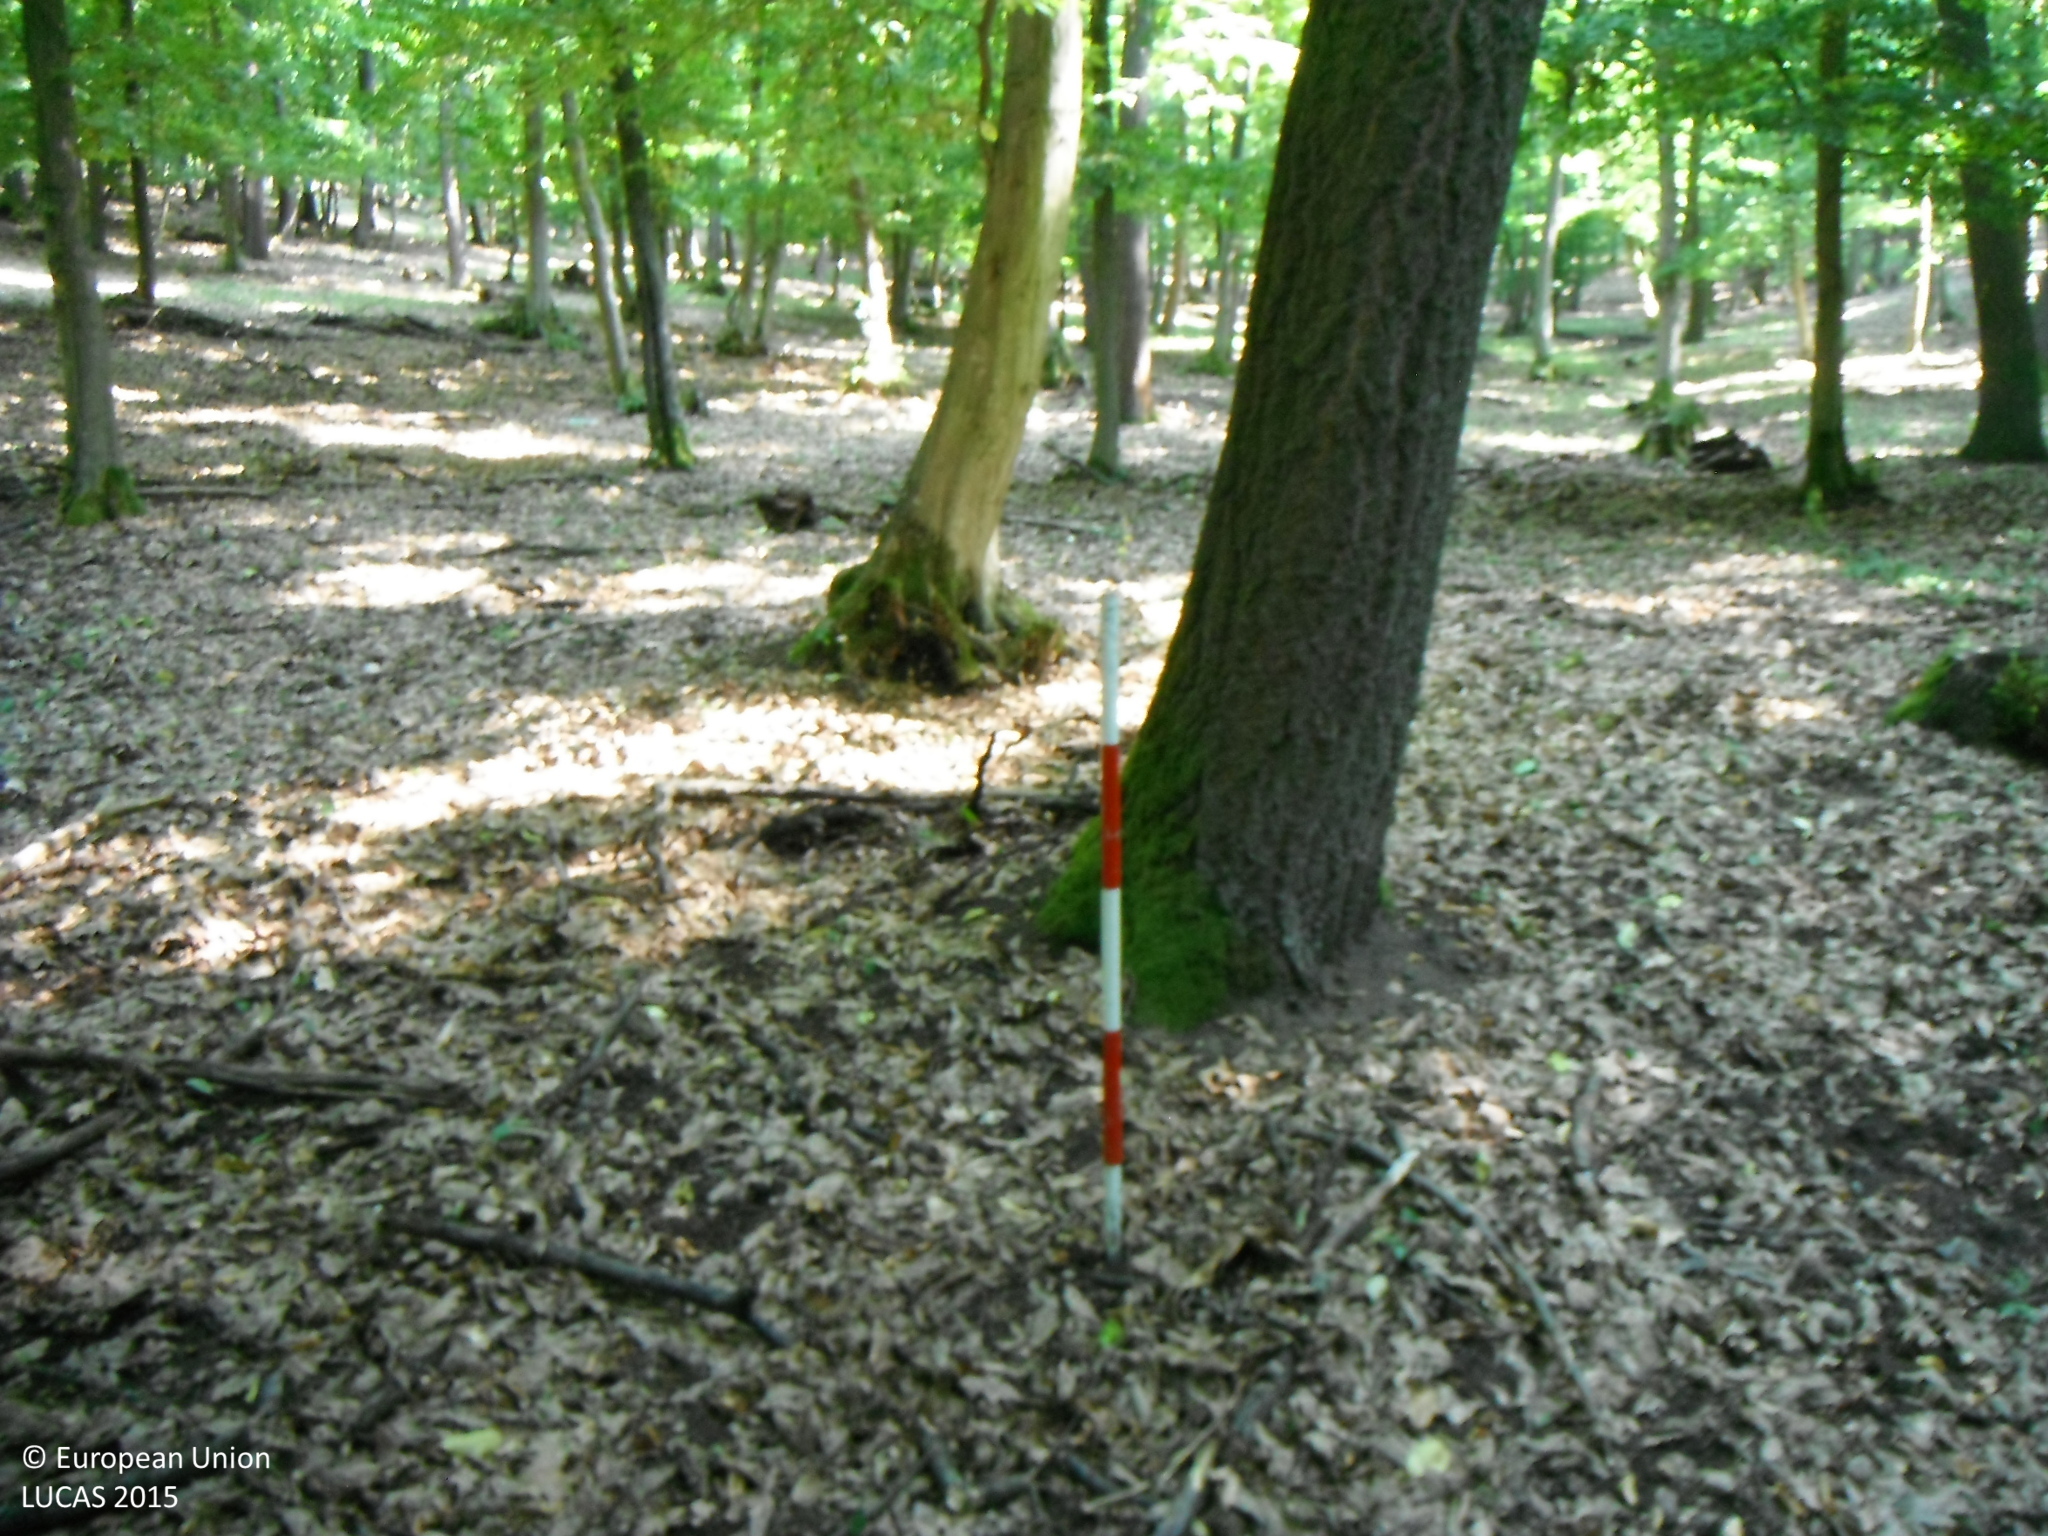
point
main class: Woodland
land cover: Broadleaved woodland
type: acidophilous oak and oak-birch forest
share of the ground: > 75 %
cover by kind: broadleaved forest trees 90 %, unconsolidated bare surface 10 %
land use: Forestry
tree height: > 5 m
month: July
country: SK
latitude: 48.3736
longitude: 20.1150
